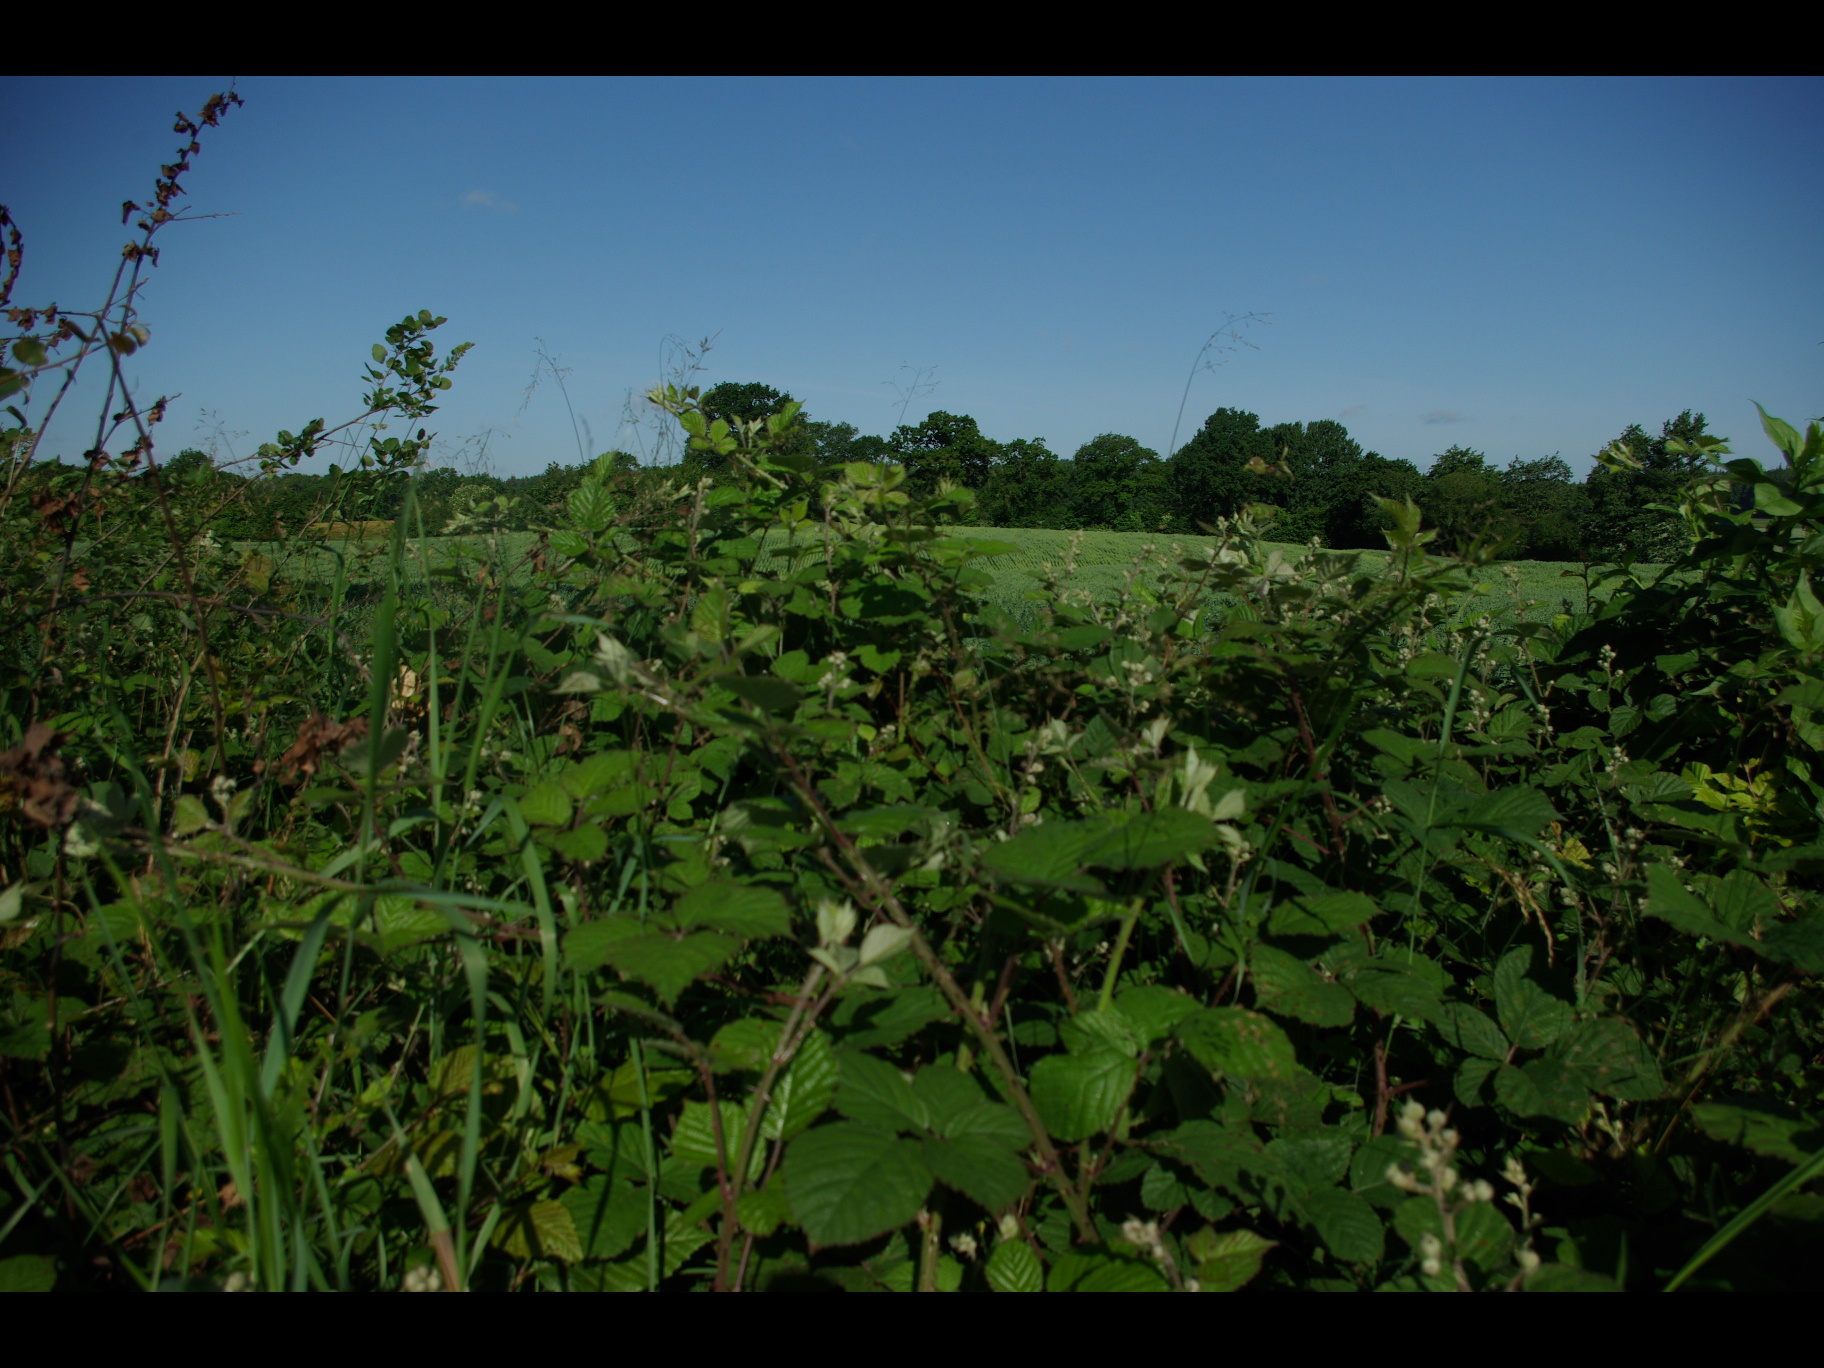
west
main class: Woodland
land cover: Broadleaved woodland
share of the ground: > 75 %
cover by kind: broadleaved forest trees 40 %, shrubs 40 %, herbaceous plants 20 %
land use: Agriculture (excluding fallow land and kitchen gardens)
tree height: > 5 m
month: June
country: DE
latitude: 54.3724
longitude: 9.9538
